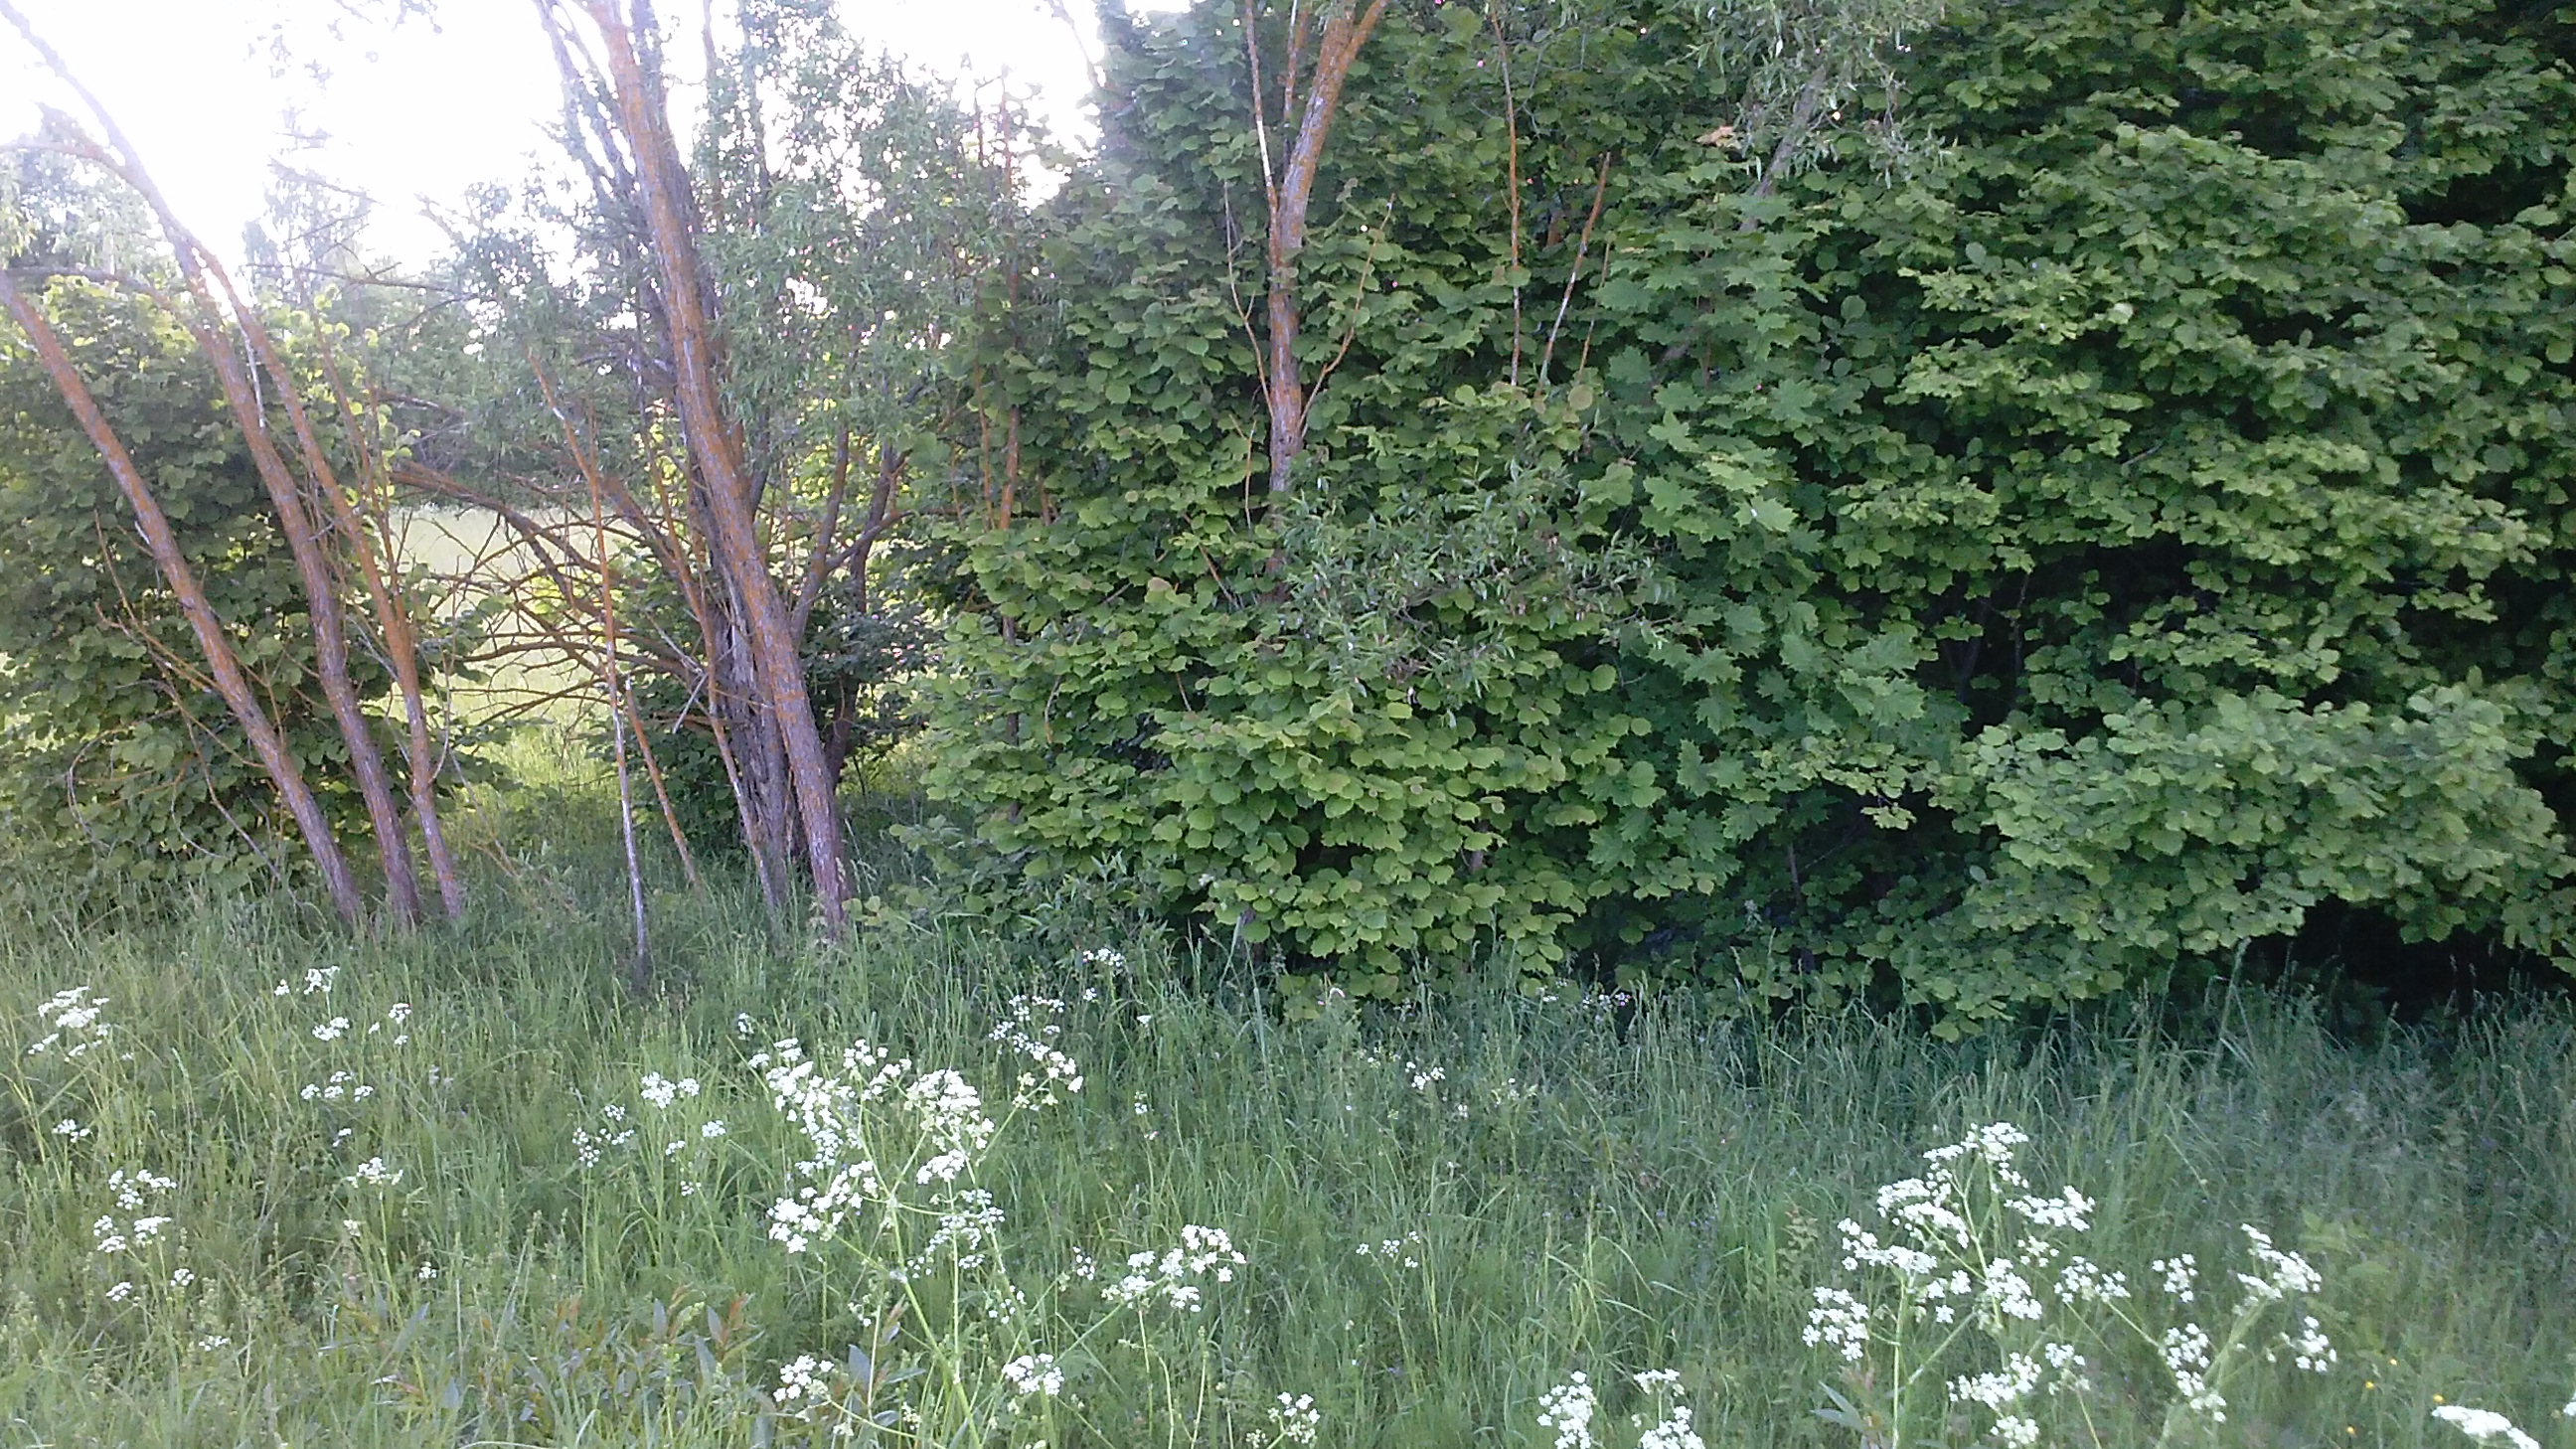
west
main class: Woodland
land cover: Broadleaved woodland
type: non-riverine alder, birch or aspen forest
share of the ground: > 75 %
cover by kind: broadleaved forest trees 100 %
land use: Forestry
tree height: > 5 m
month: June
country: LV
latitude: 56.4691
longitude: 28.0034
